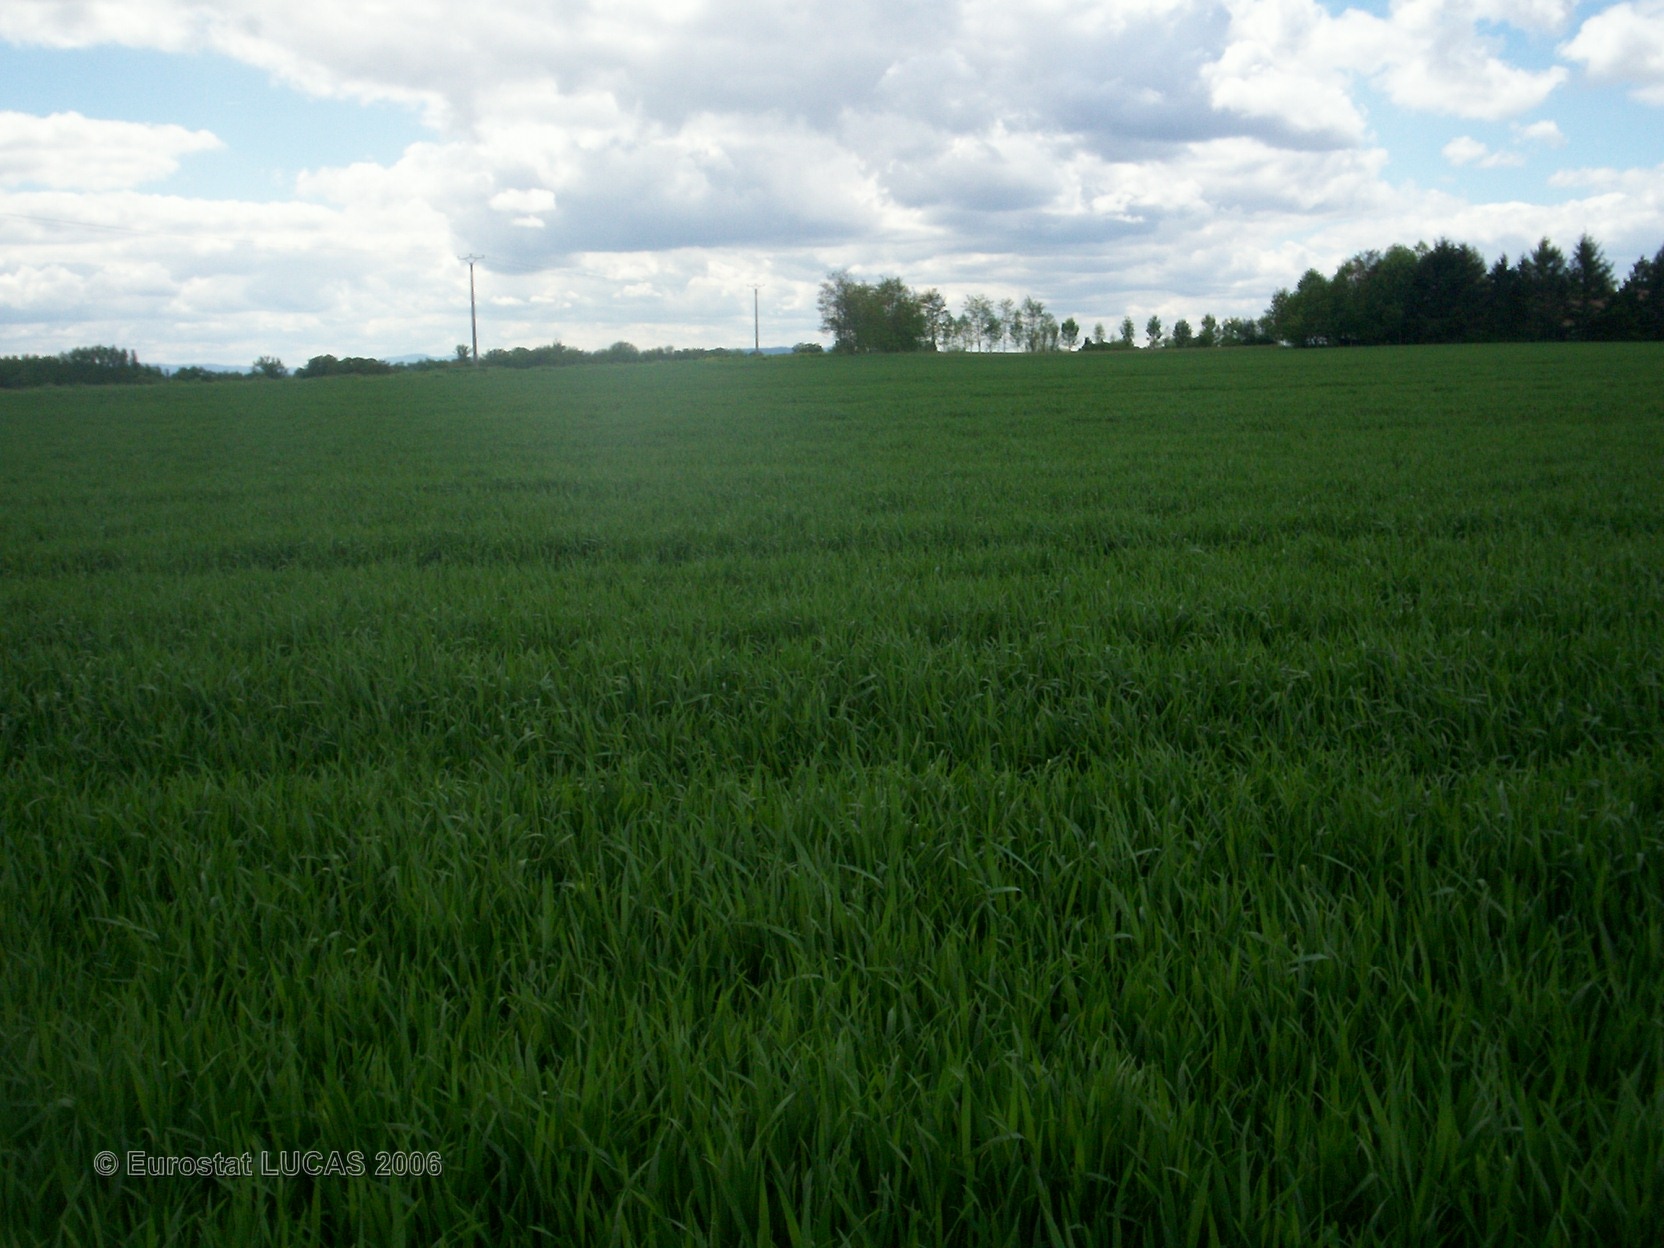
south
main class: Cropland
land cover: Common wheat
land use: Agriculture (excluding fallow land and kitchen gardens)
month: May
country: FR
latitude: 45.9214
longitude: 3.2561
